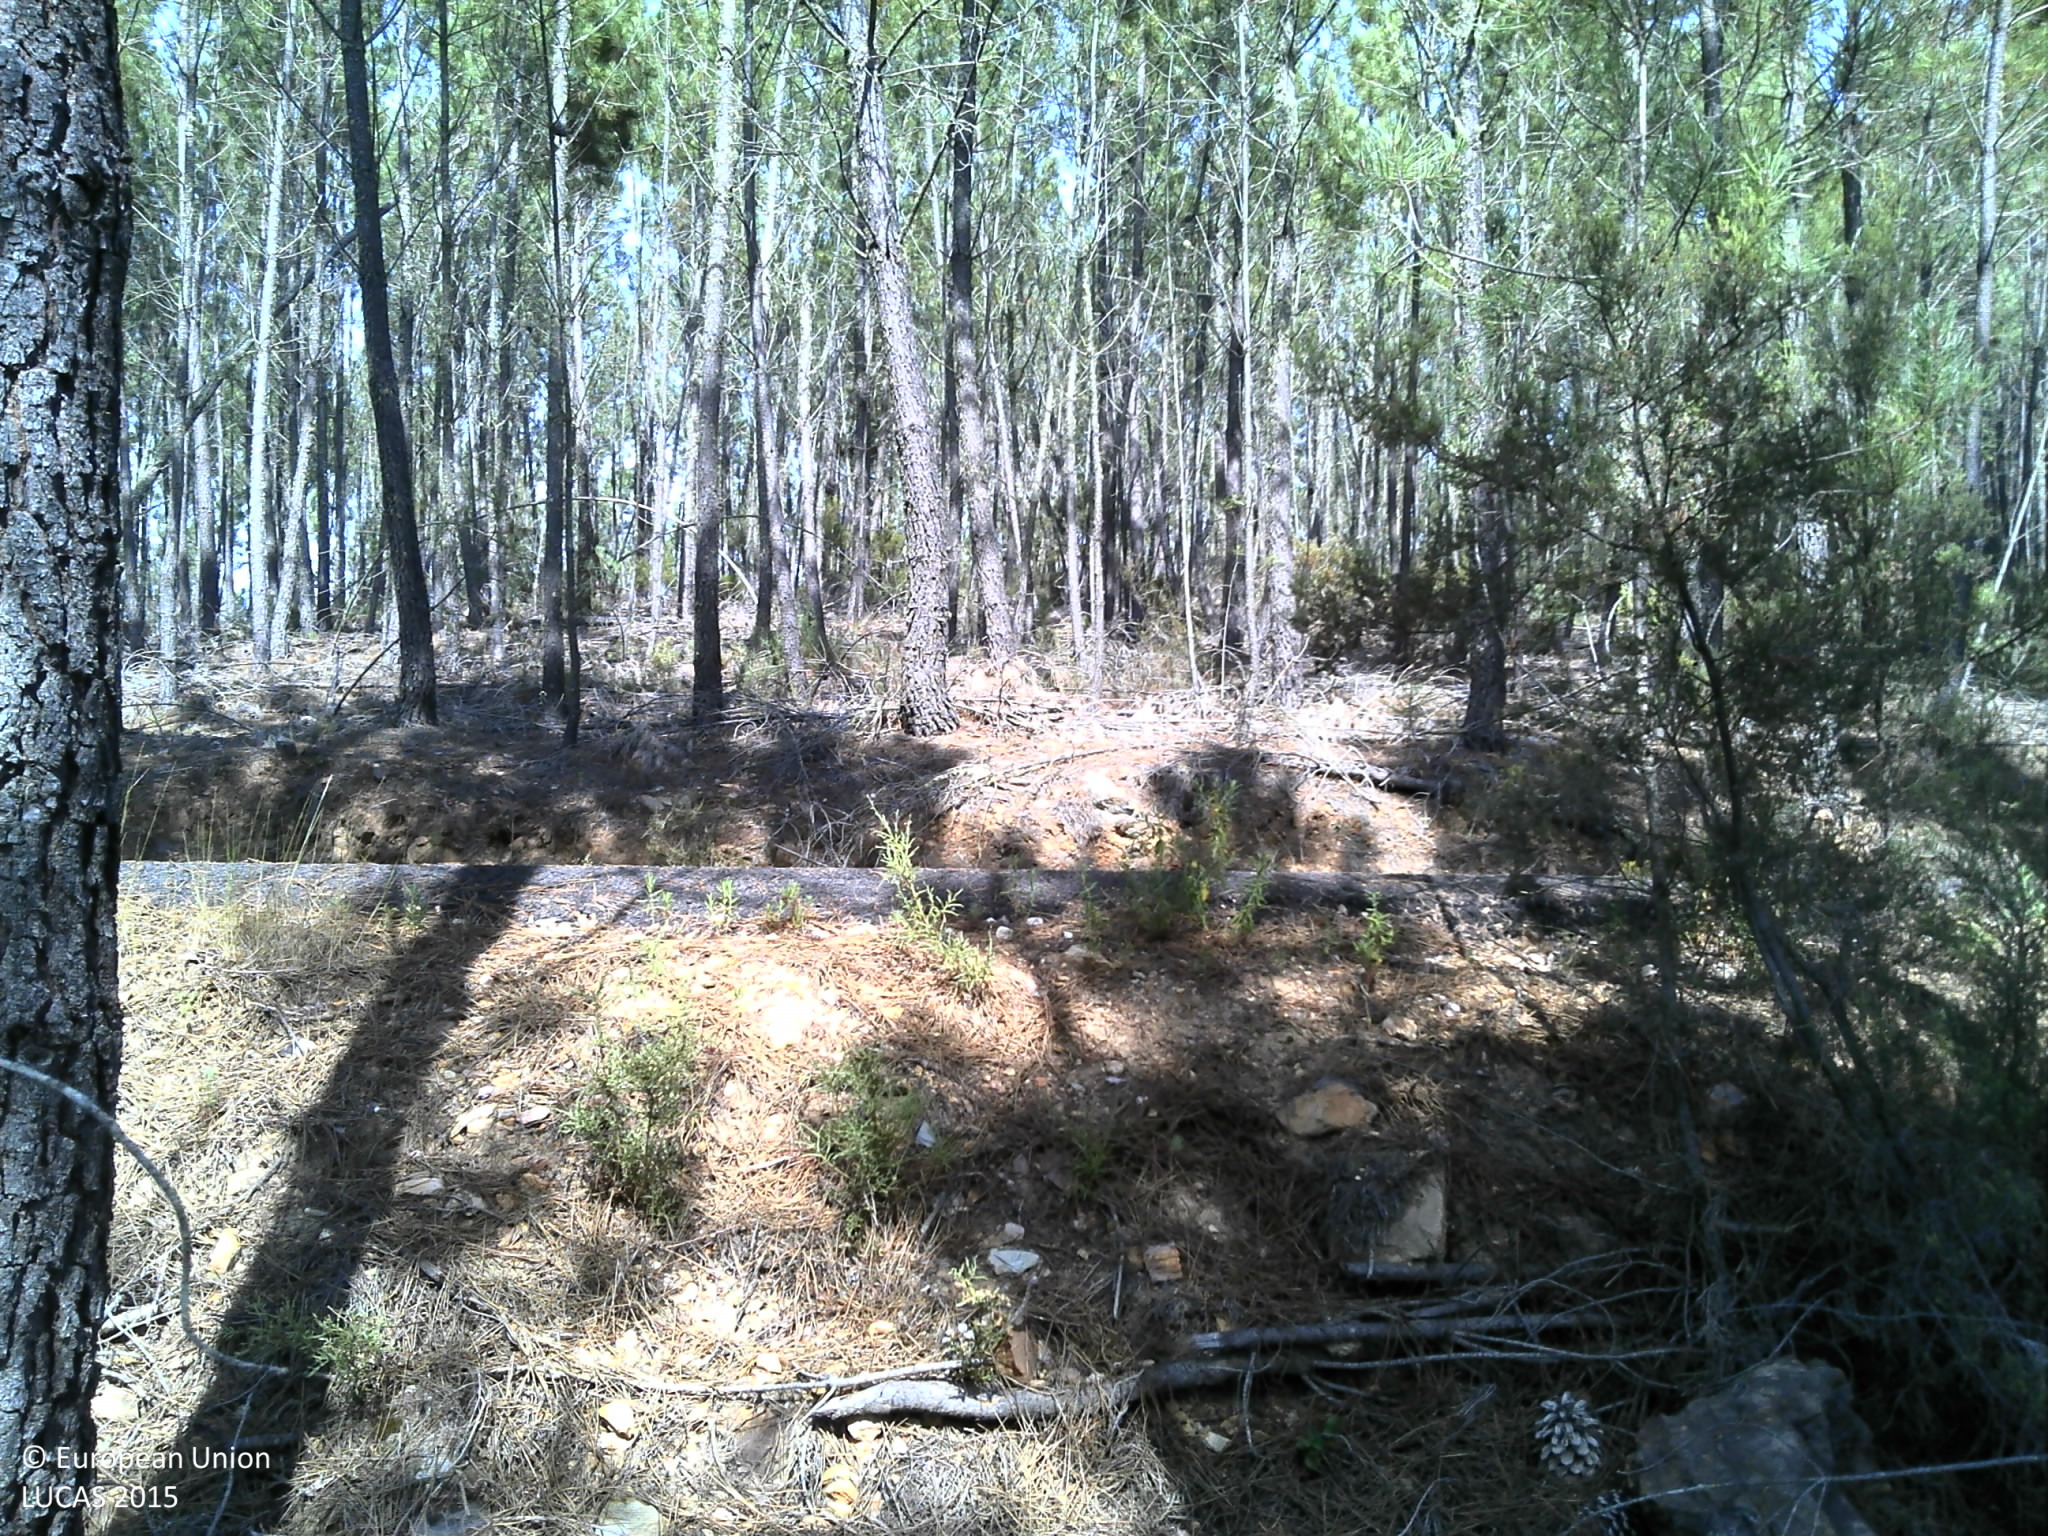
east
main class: Woodland
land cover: Pine dominated coniferous woodland
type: coniferous forest of the mediterranean region
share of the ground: 10 - 25 %
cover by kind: unconsolidated bare surface 65 %, shrubs 20 %, coniferous forest trees 15 %
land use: Forestry
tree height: > 5 m
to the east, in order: Pine dominated coniferous woodland; Ditches and canals; Pine dominated coniferous woodland; Tracks; Pine dominated coniferous woodland
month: July
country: PT
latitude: 39.9427
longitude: -7.8647
